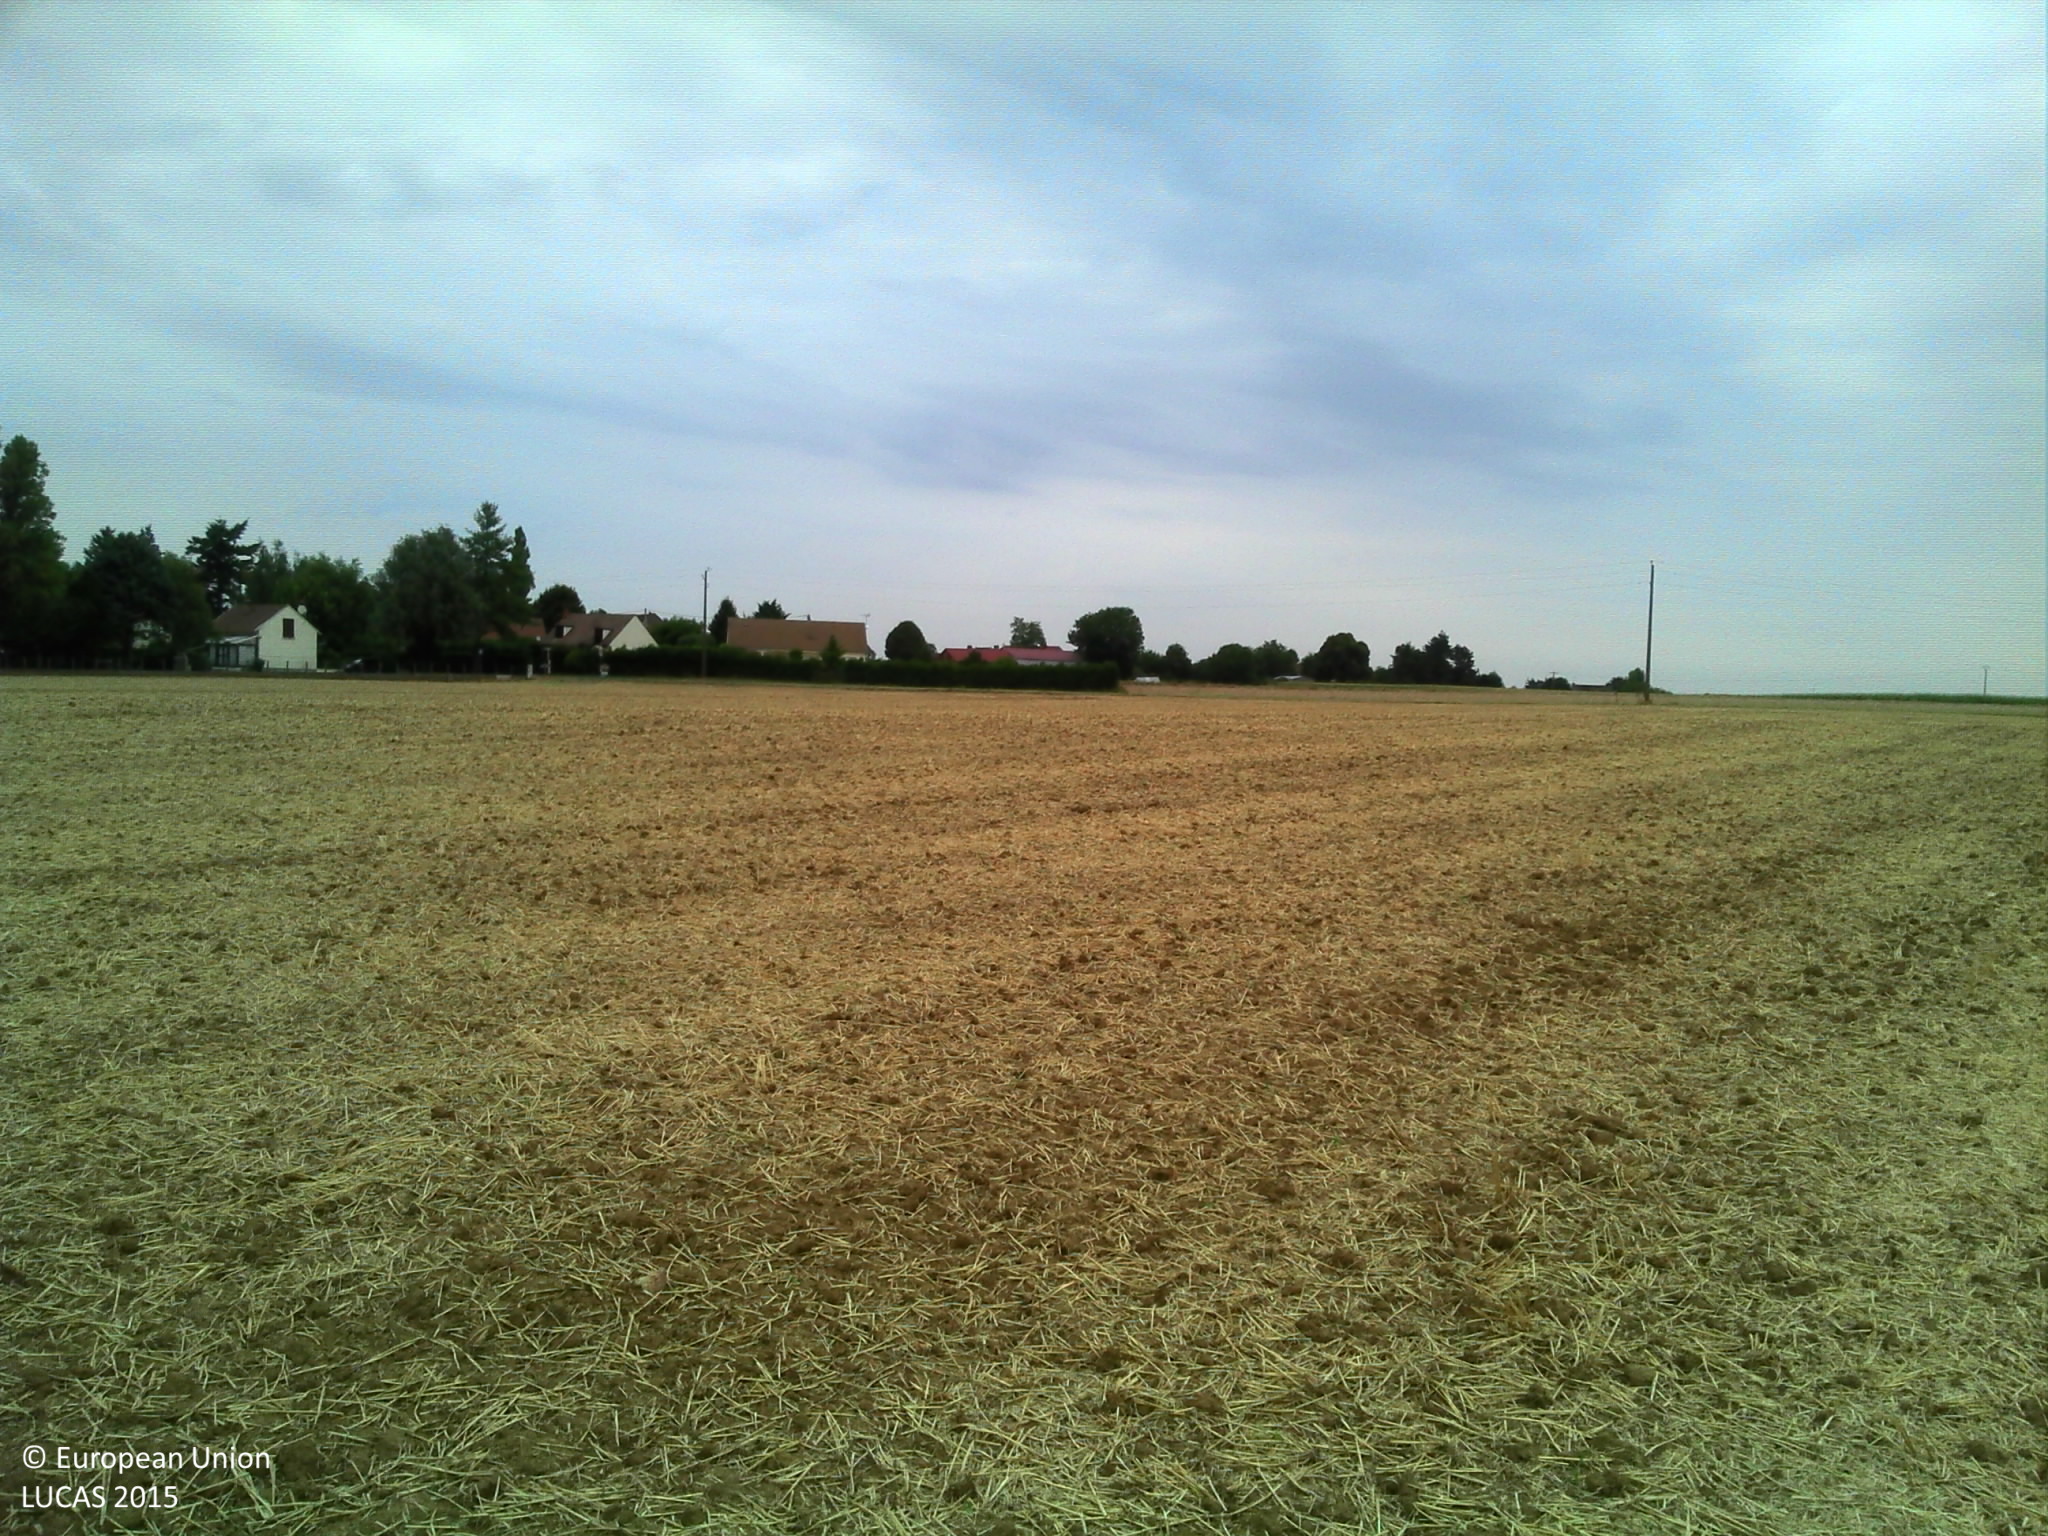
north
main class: Cropland
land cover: Barley
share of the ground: 10 - 25 %
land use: Agriculture (excluding fallow land and kitchen gardens)
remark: Harvested field
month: August
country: FR
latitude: 48.2294
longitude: 2.6268
